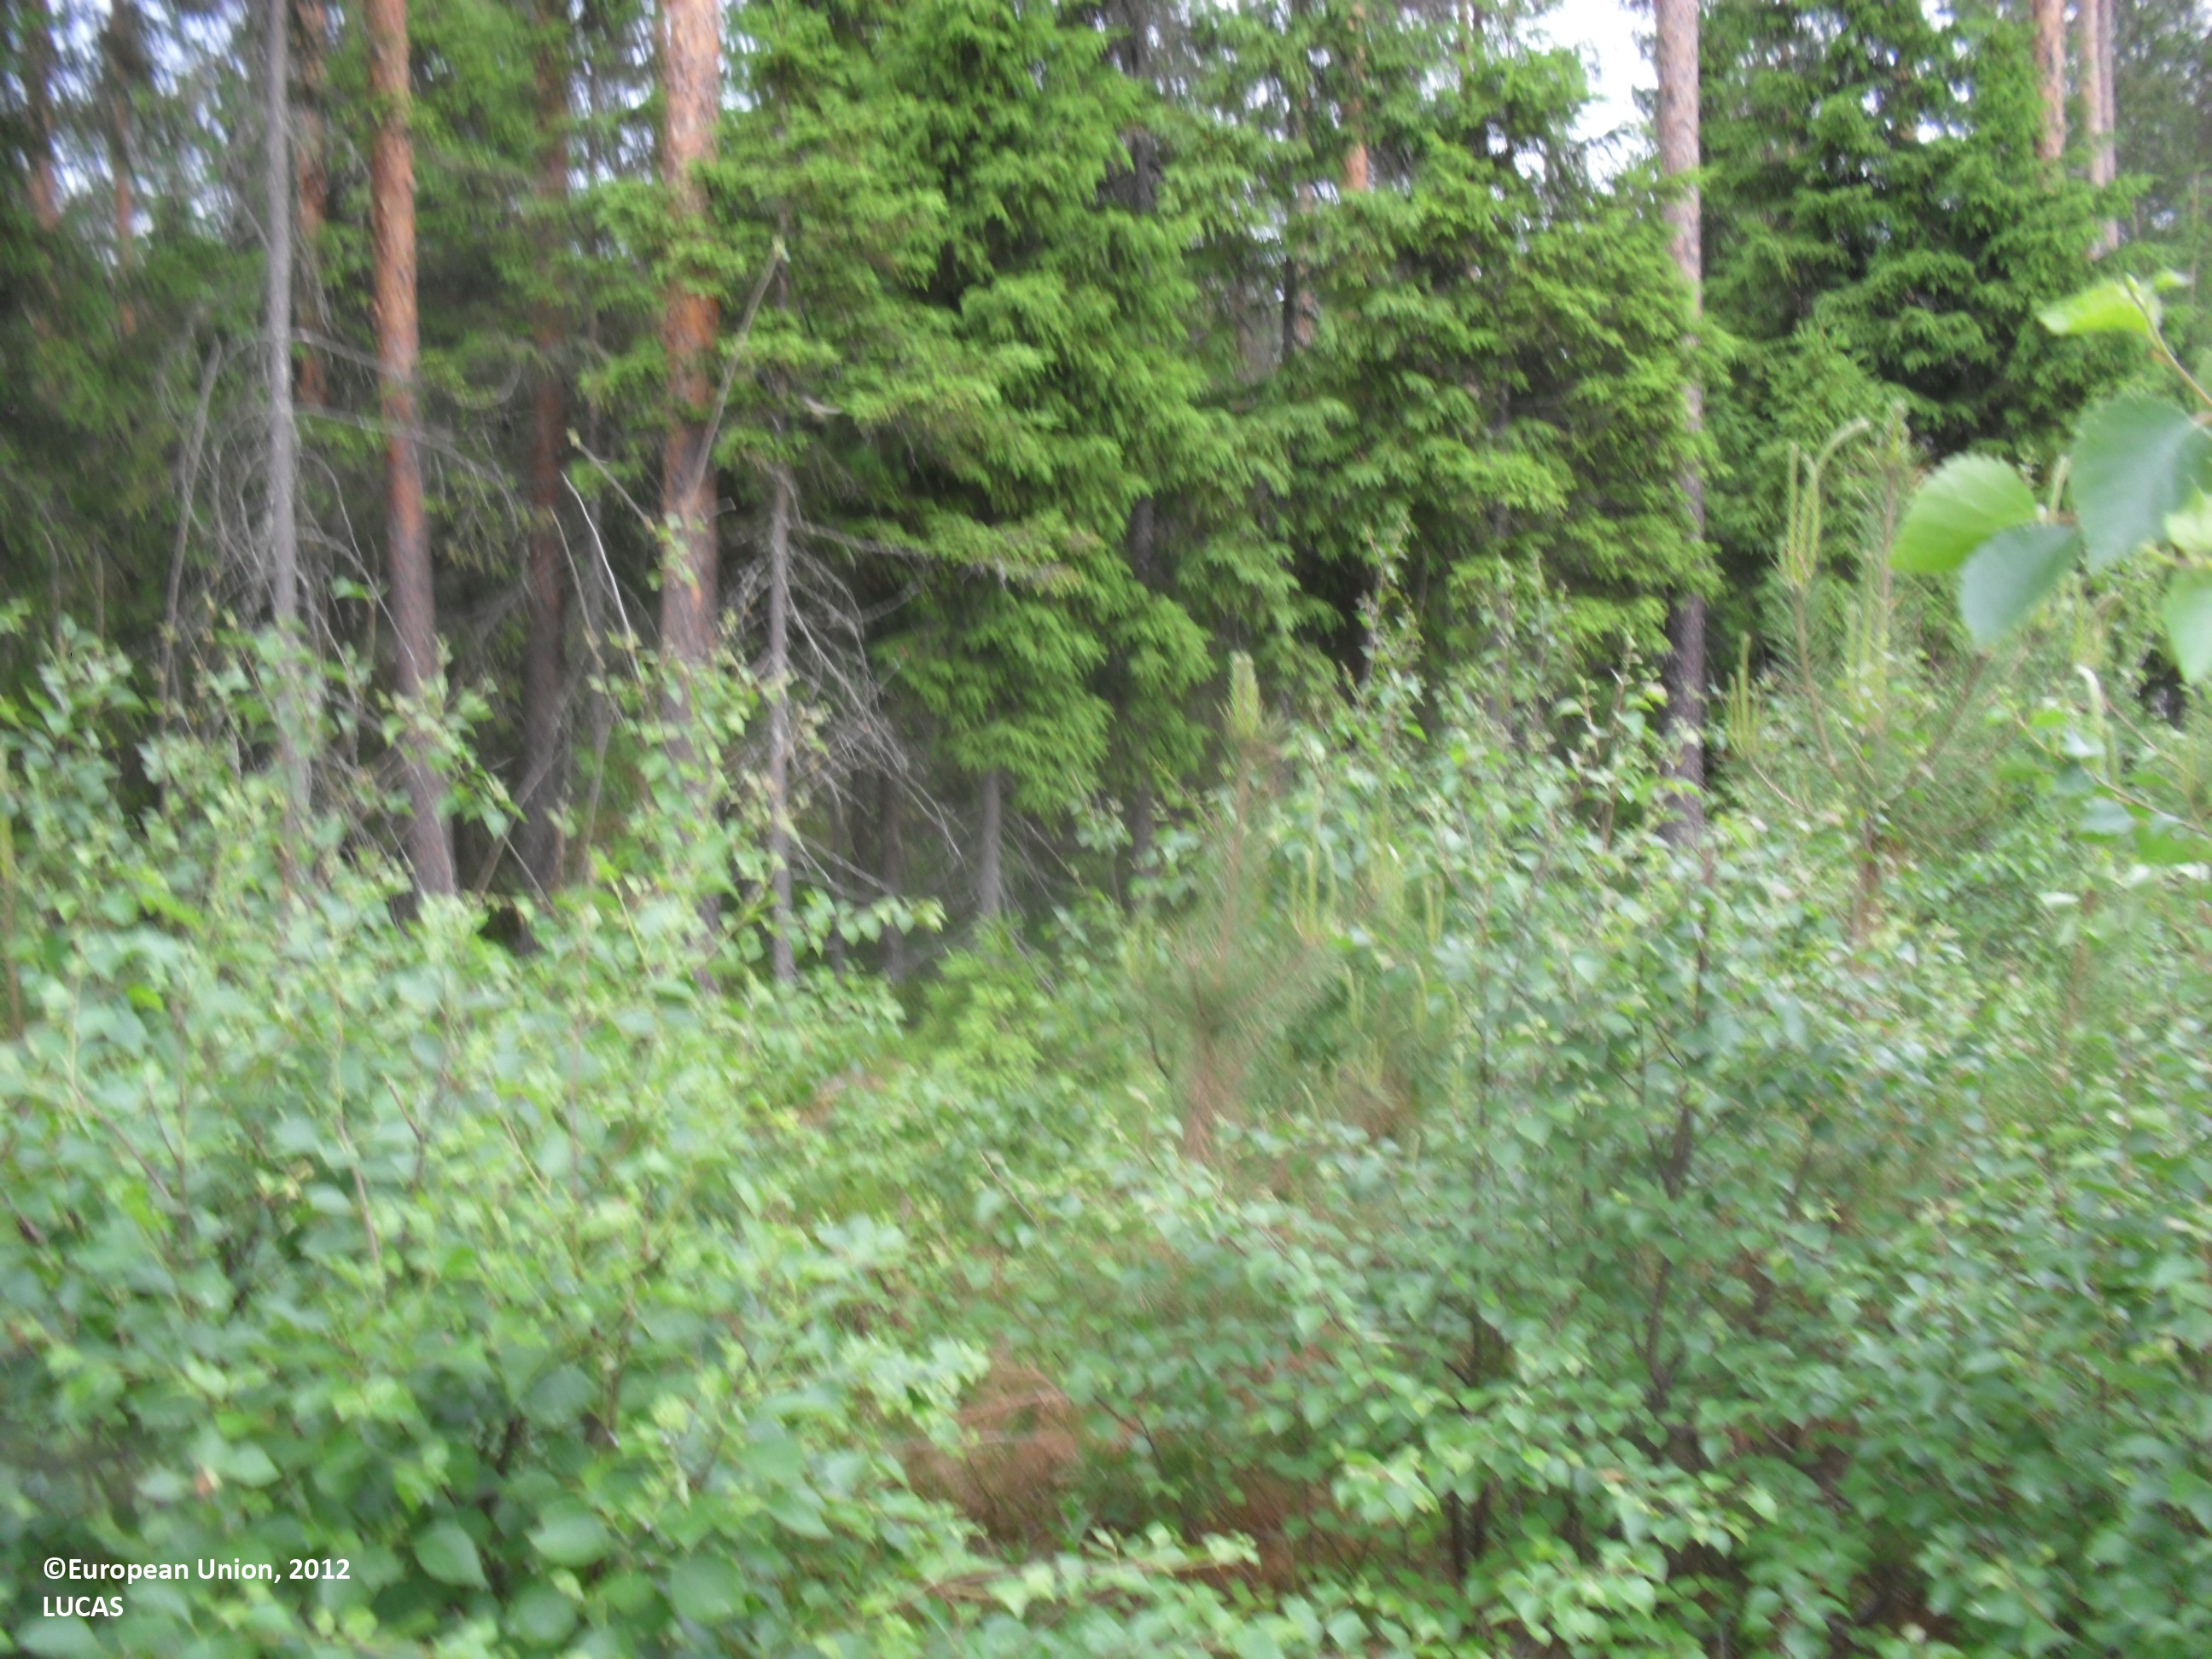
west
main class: Woodland
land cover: Other mixed woodland
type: boreal forest
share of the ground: 50 - 75 %
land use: Forestry
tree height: < 5 m
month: June
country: FI
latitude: 63.4854
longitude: 22.8822
